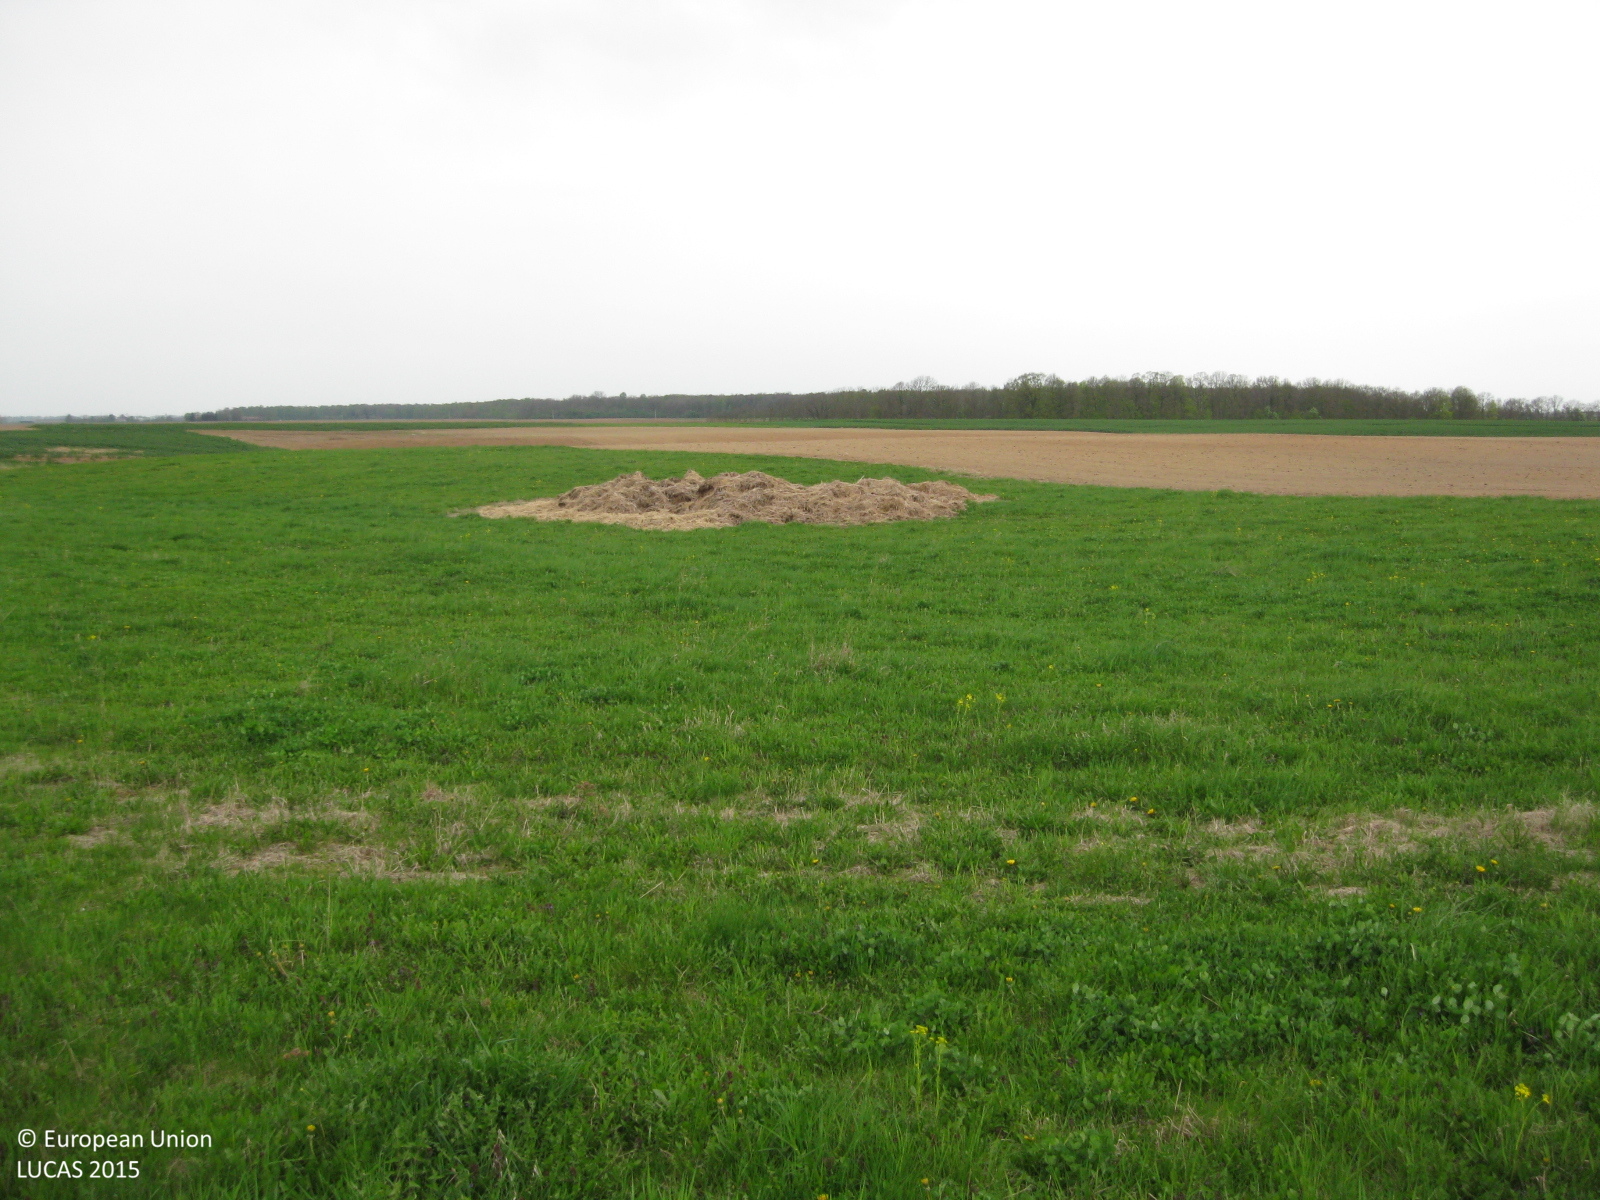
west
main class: Grassland
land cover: Grassland without tree/shrub cover
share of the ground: > 75 %
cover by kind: herbaceous plants 95 %, unconsolidated bare surface 5 %
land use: Agriculture (excluding fallow land and kitchen gardens)
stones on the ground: < 10 %
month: May
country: LT
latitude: 56.1308
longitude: 24.4644
